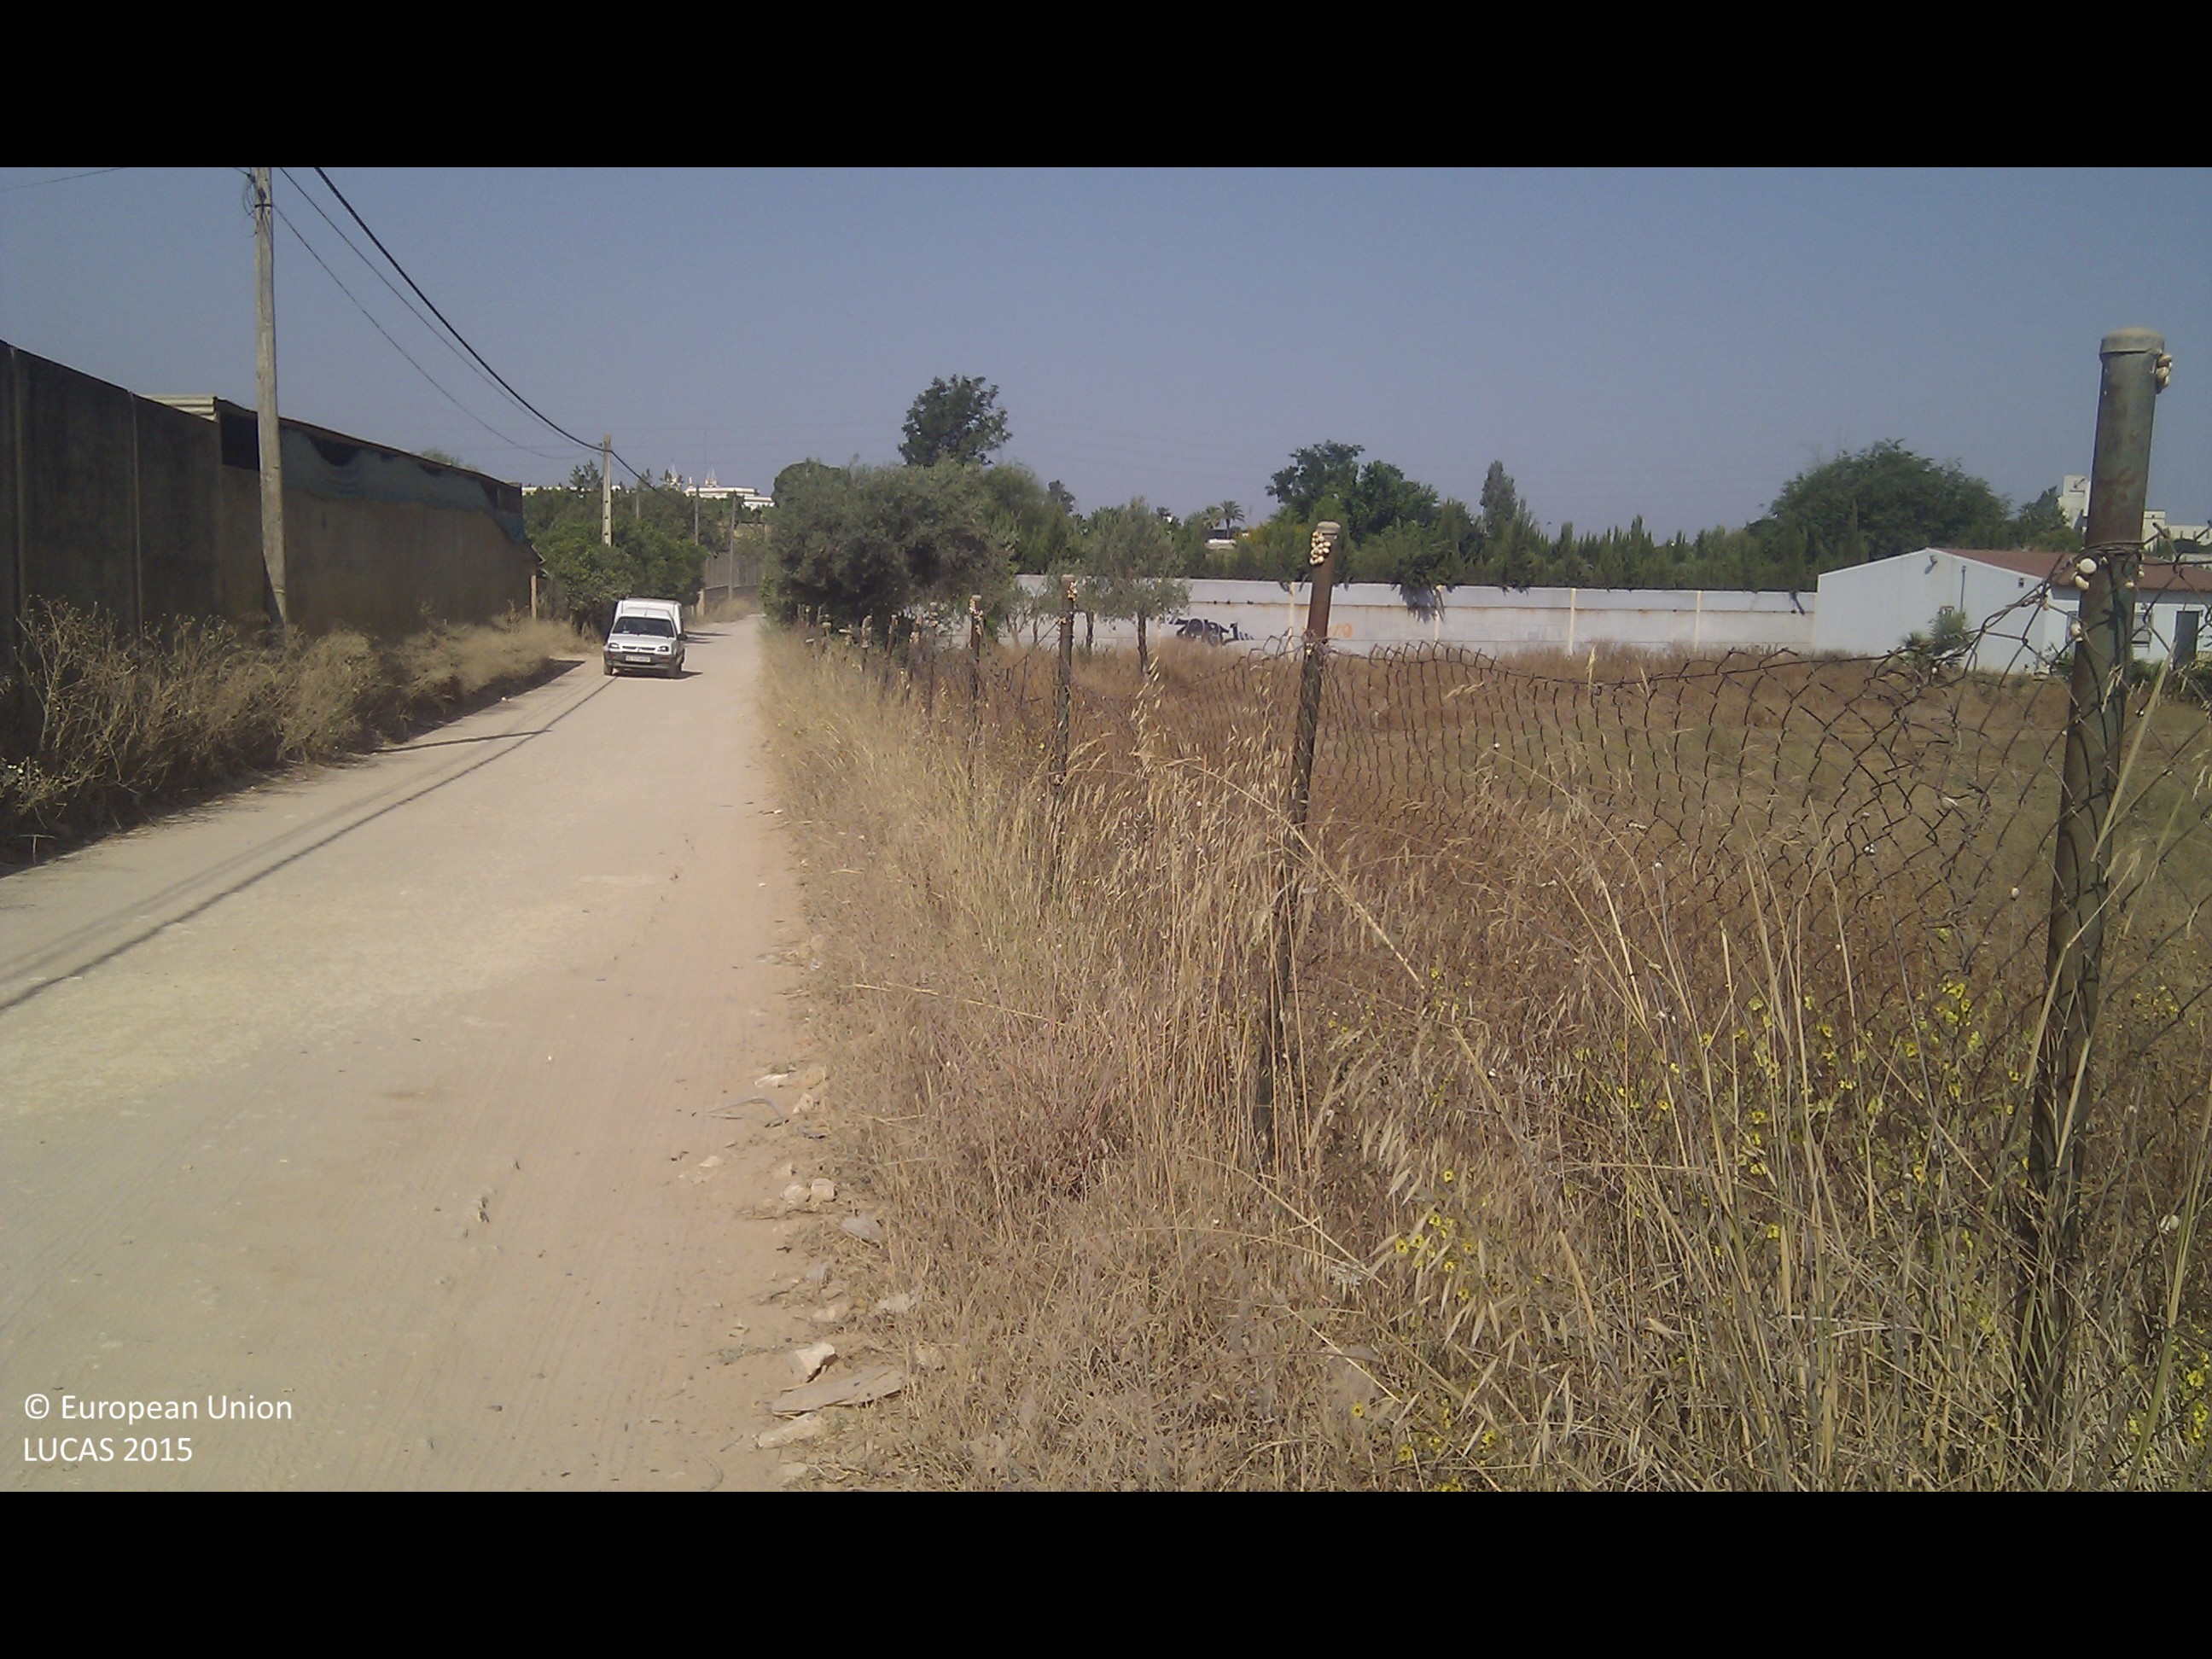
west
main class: Woodland
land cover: Broadleaved woodland
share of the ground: 25 - 50 %
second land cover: Grassland without tree/shrub cover
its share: 50 - 75 %
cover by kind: herbaceous plants 50 %, broadleaved forest trees 25 %, unconsolidated bare surface 15 %
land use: Forestry
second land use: Agriculture (excluding fallow land and kitchen gardens)
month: June
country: ES
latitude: 37.2871
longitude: -5.8904
